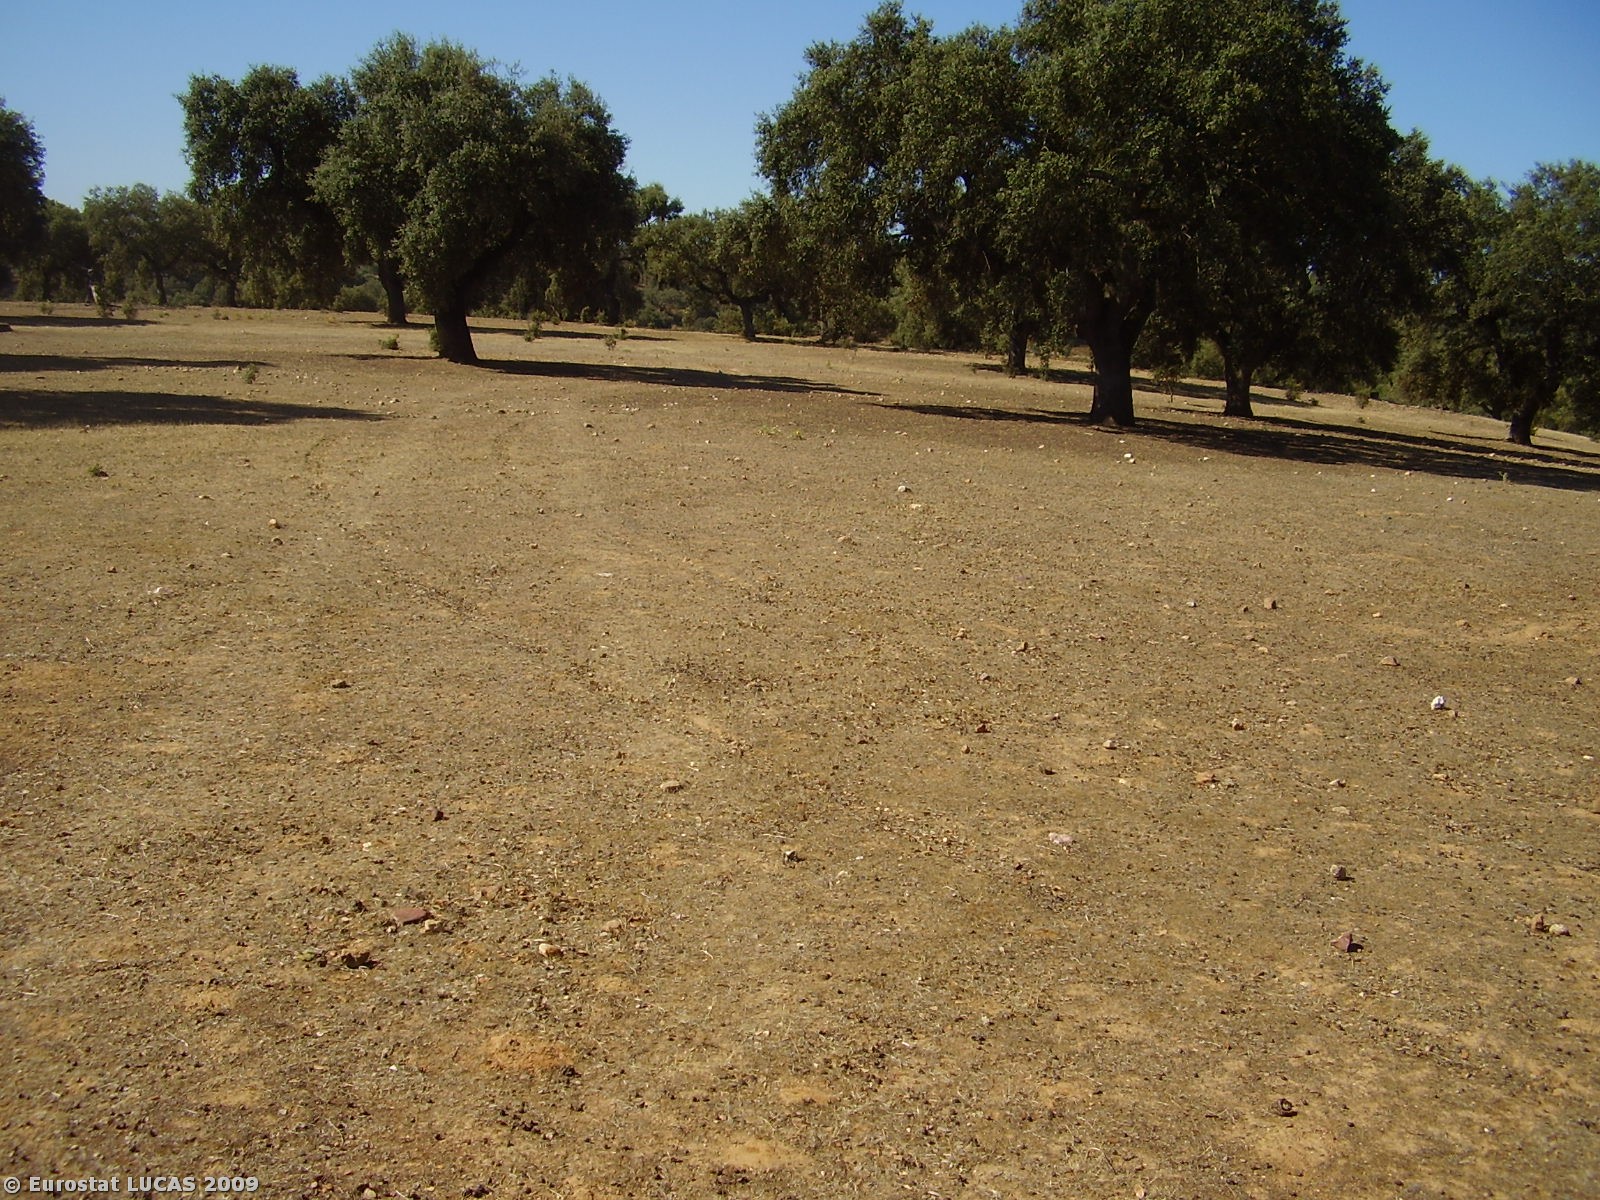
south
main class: Woodland
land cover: Broadleaved woodland
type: broadleaved evergreen forest
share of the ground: 10 - 25 %
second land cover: Bare land
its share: 50 - 75 %
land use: Forestry
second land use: Fallow land
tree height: > 5 m
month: July
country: PT
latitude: 38.8779
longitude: -7.8294
